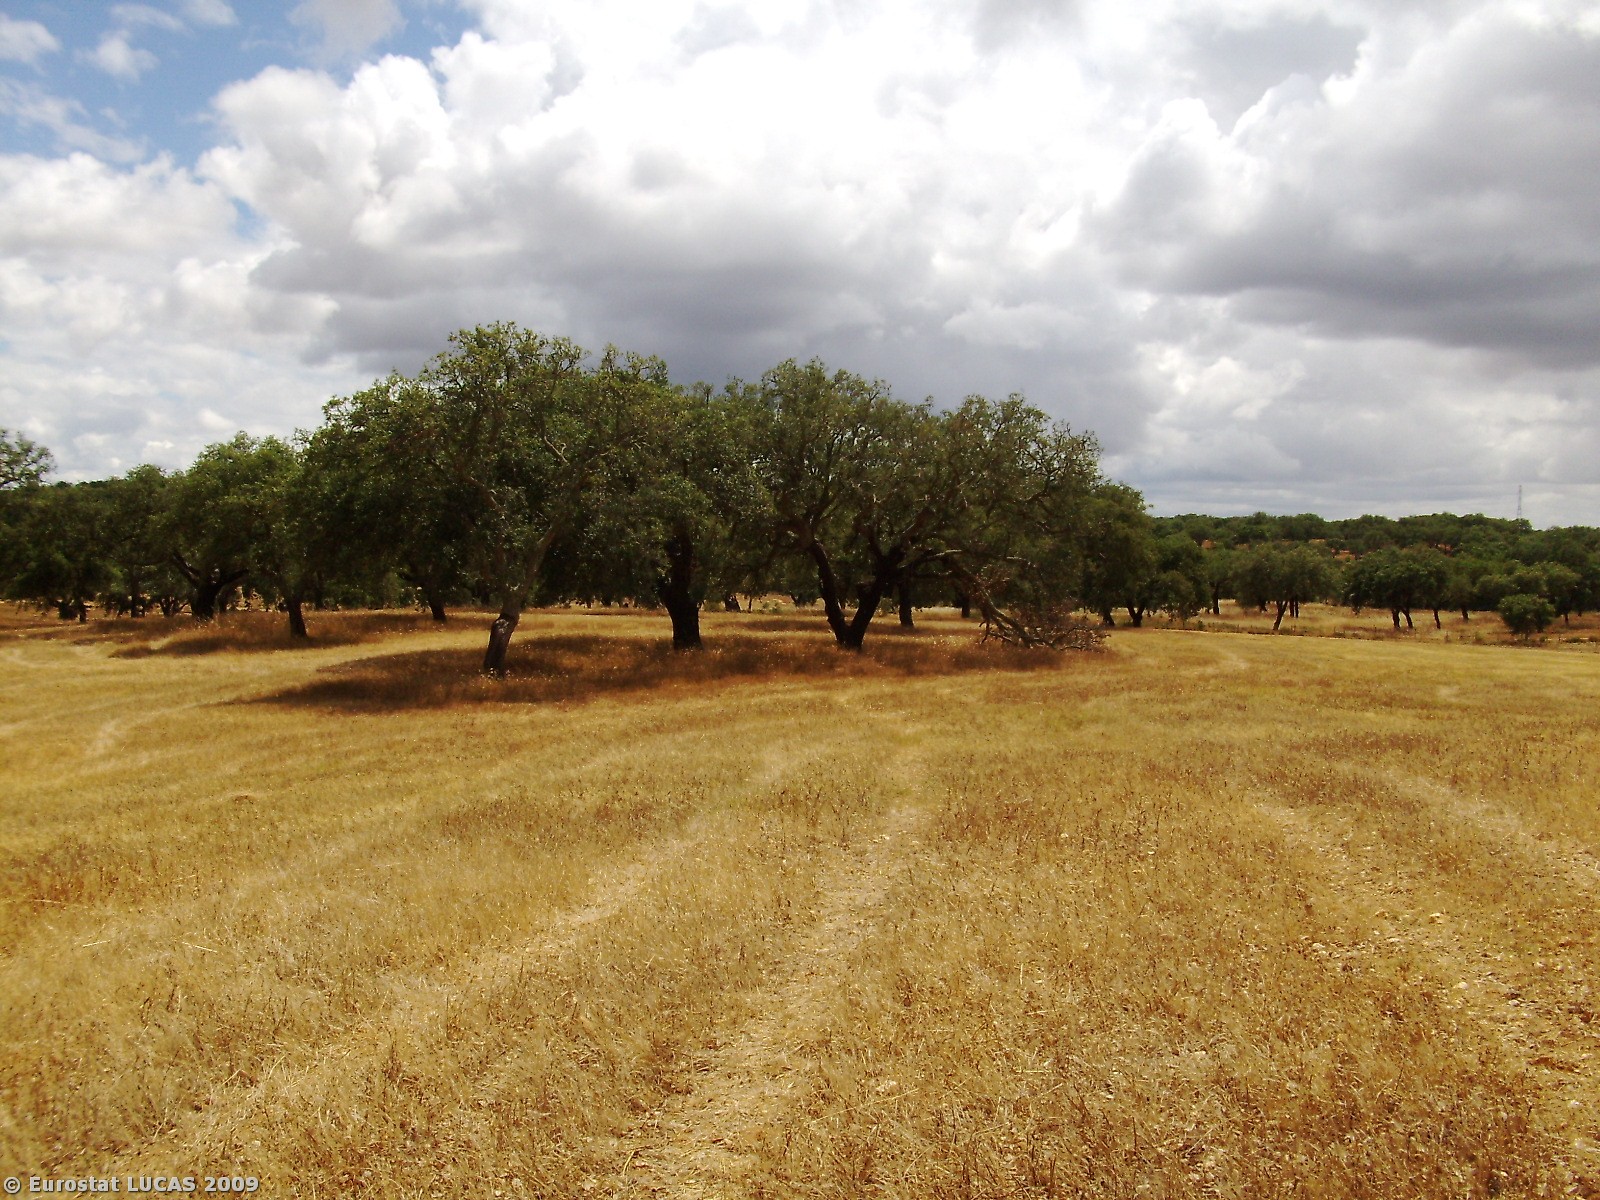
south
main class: Woodland
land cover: Broadleaved woodland
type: broadleaved evergreen forest
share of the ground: 10 - 25 %
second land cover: Spontaneously vegetated surfaces
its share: 50 - 75 %
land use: Forestry
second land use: Fallow land
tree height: > 5 m
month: June
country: PT
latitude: 37.8237
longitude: -8.4074
